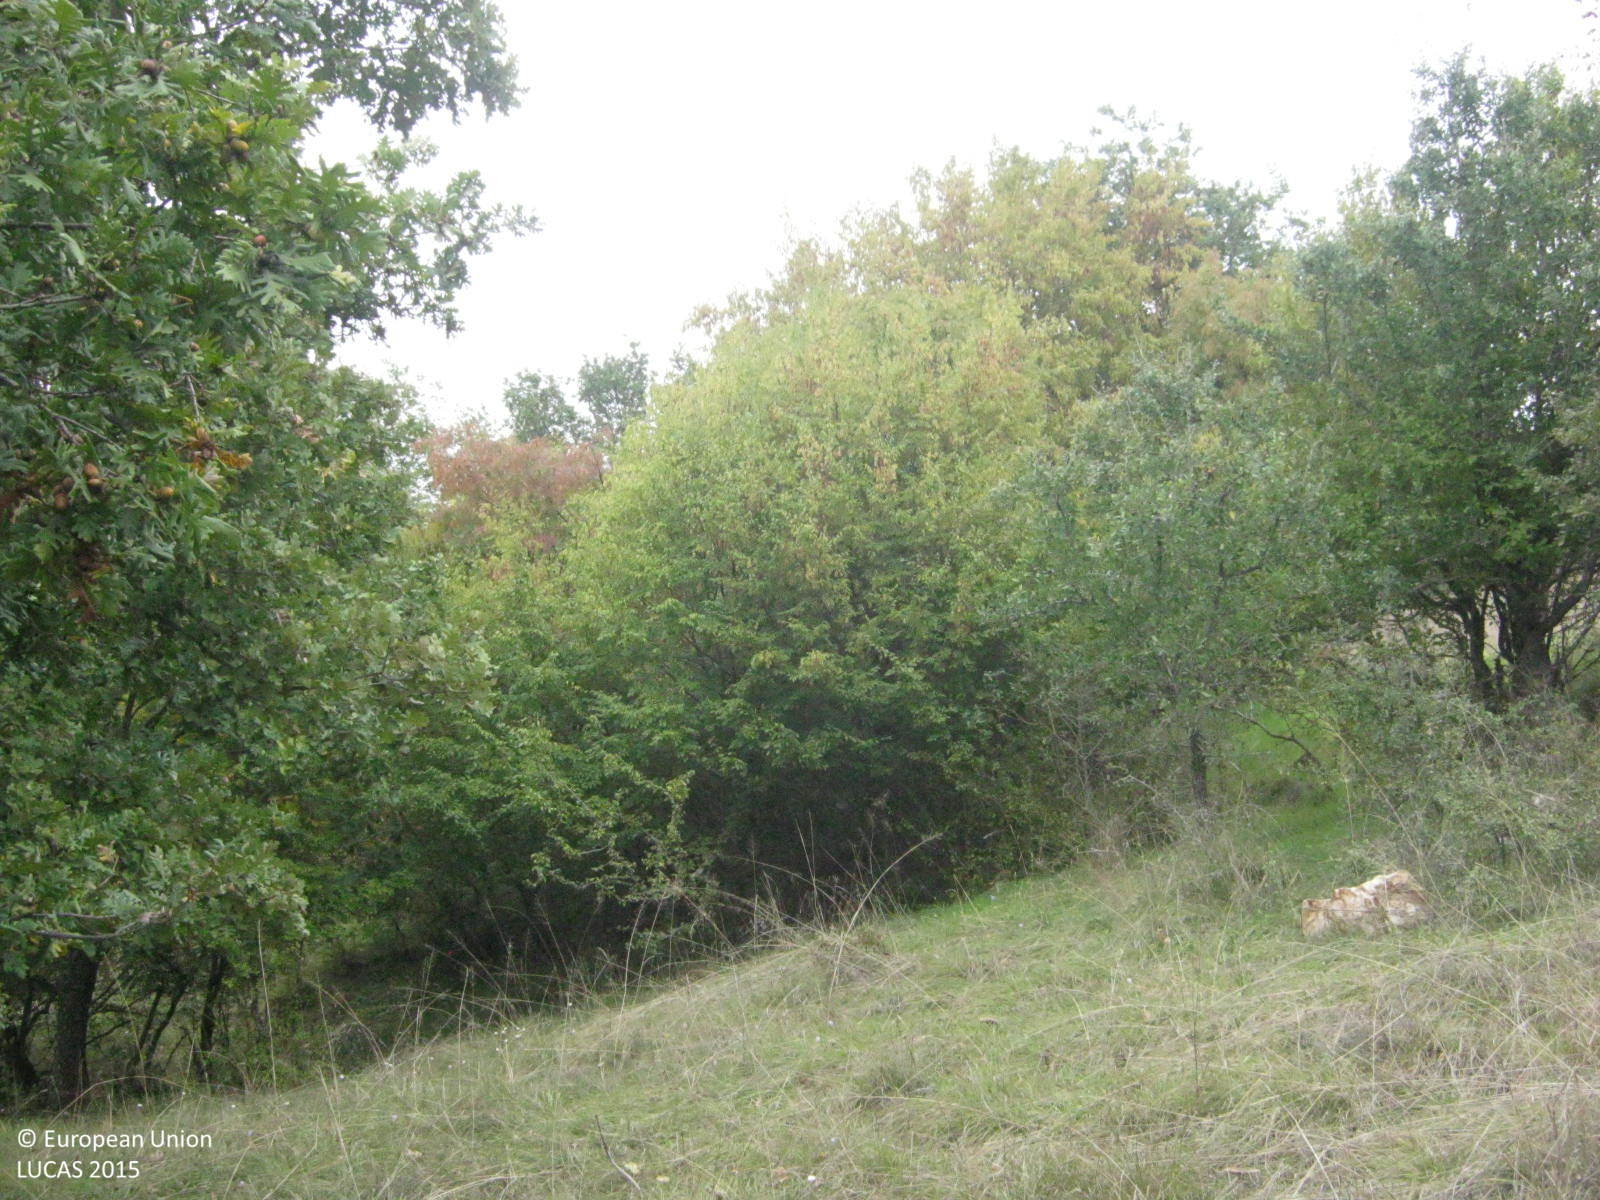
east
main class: Grassland
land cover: Spontaneously vegetated surfaces
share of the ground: > 75 %
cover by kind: herbaceous plants 90 %, unconsolidated bare surface 10 %
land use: Fallow land
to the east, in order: Spontaneously vegetated surfaces; Broadleaved woodland; Inland fresh running water; Broadleaved woodland
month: October
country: GR
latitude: 41.0960
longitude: 23.0264
